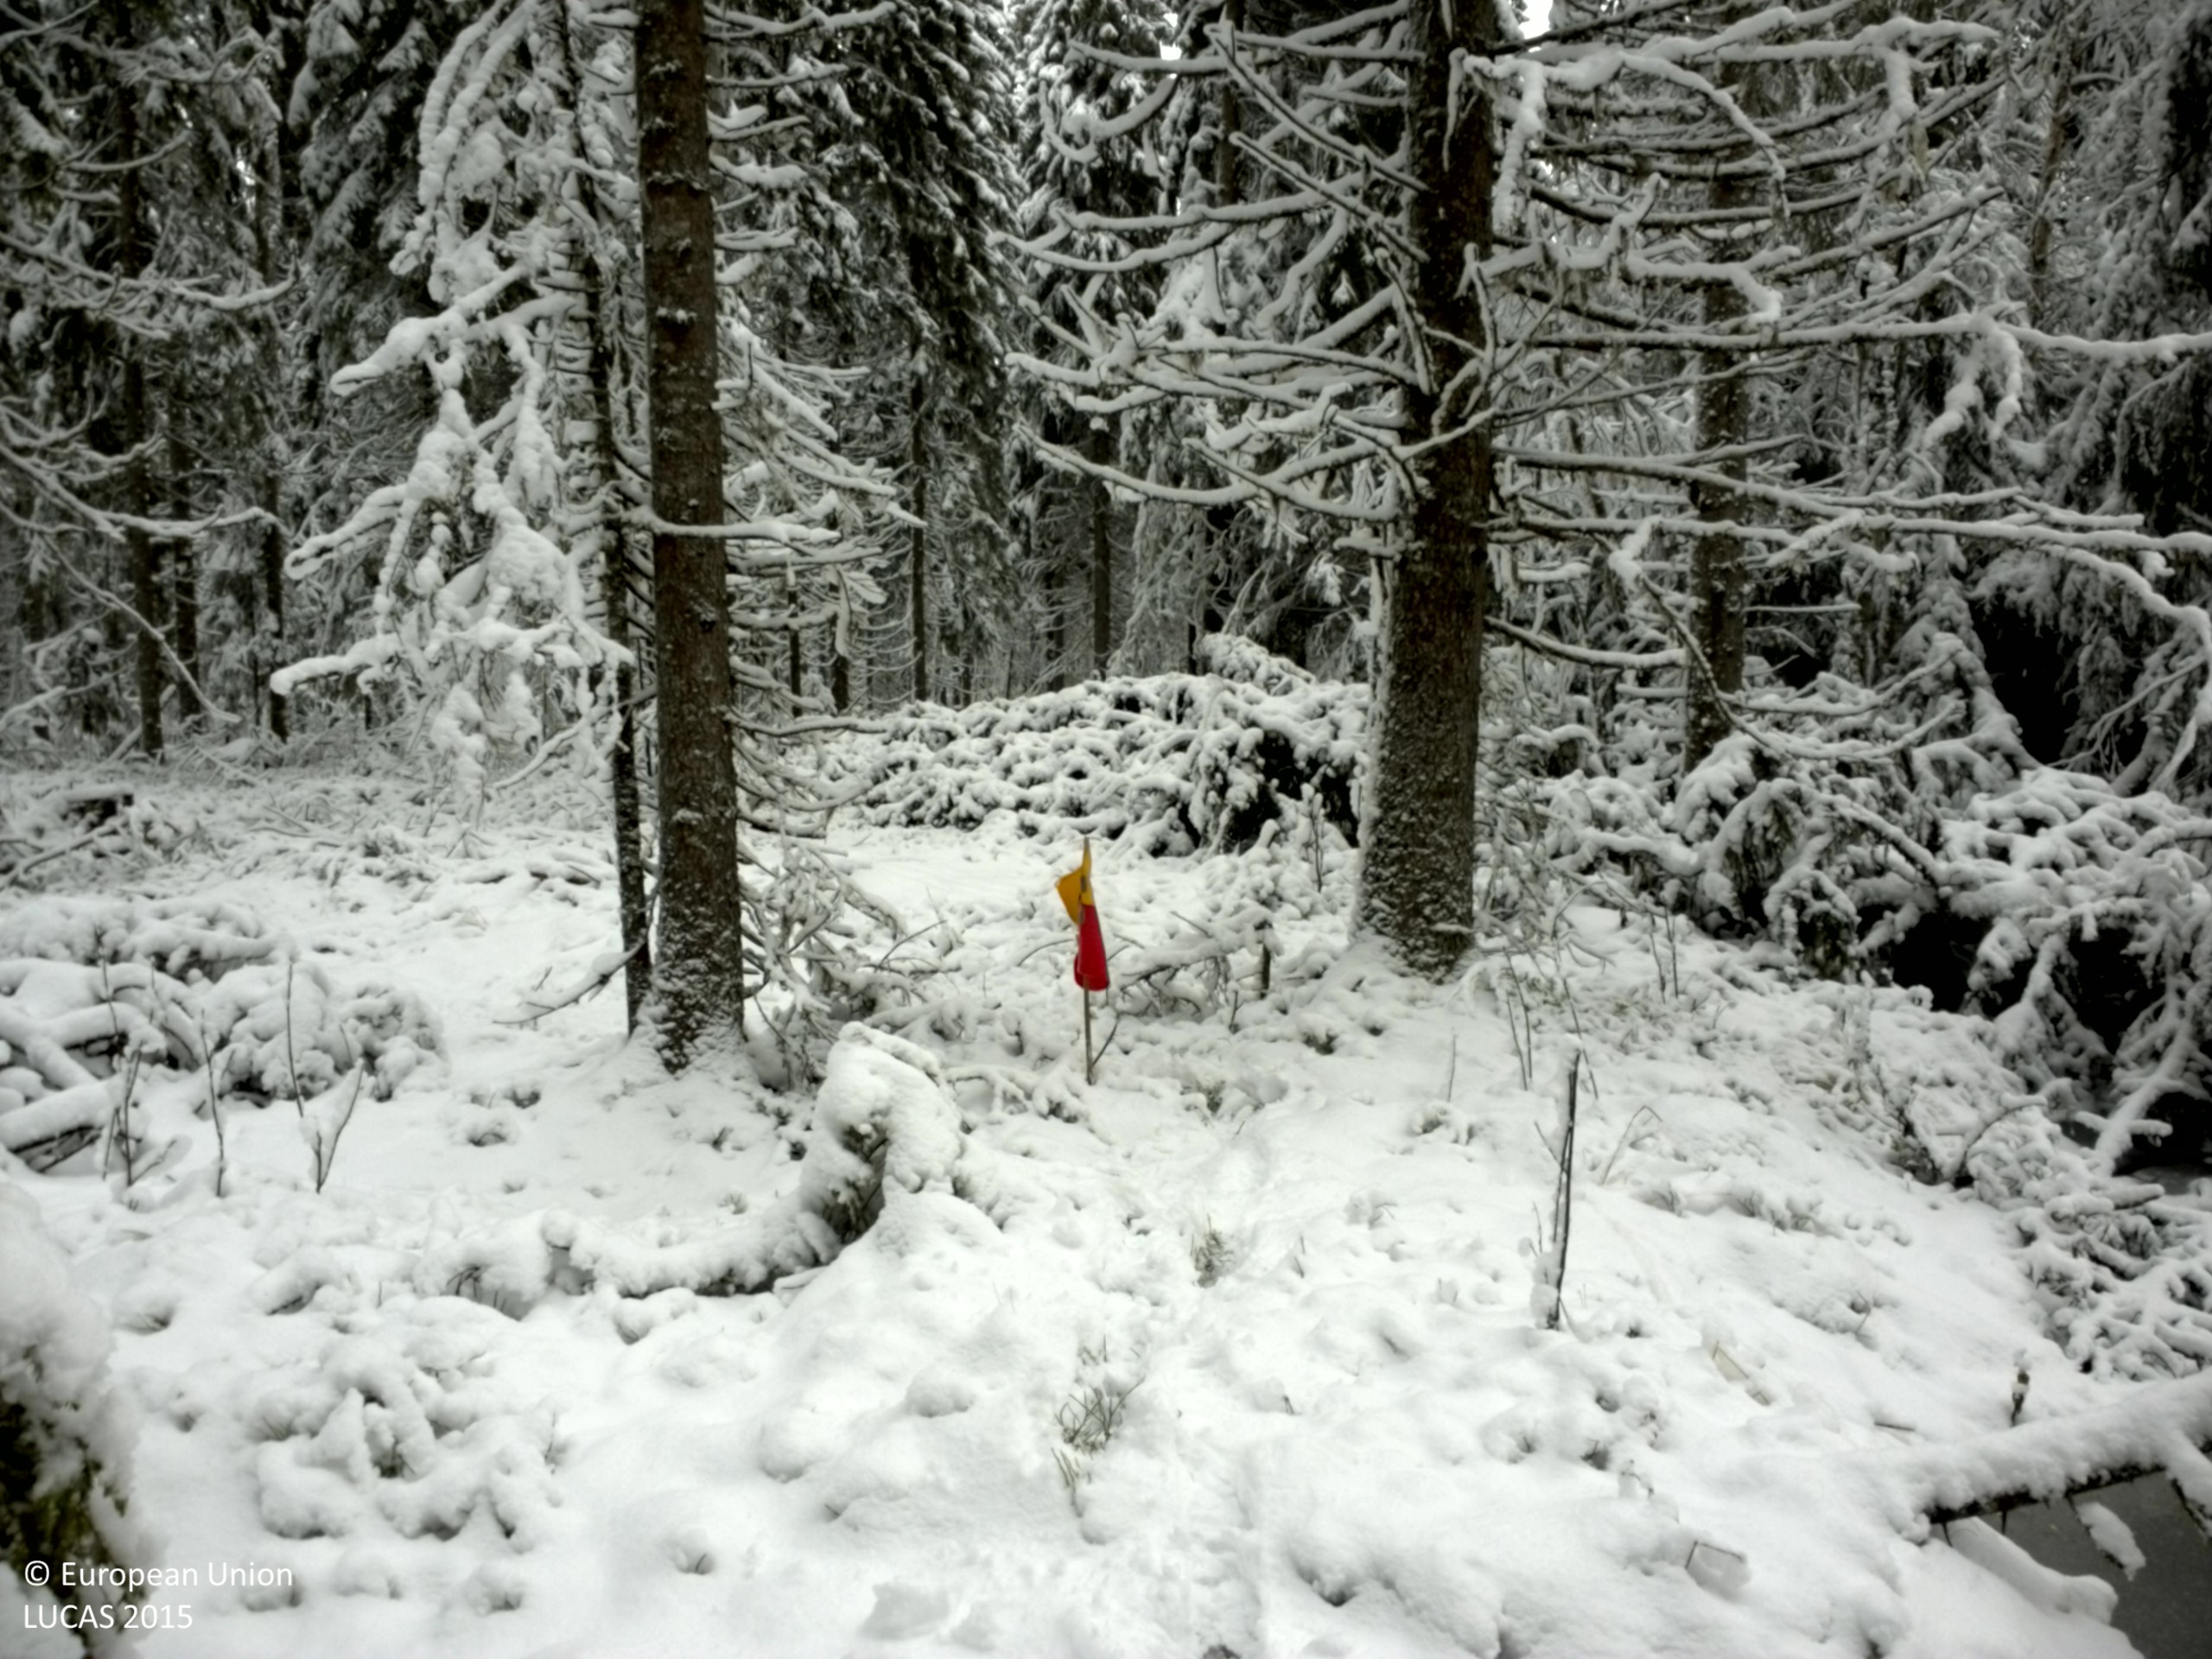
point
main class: Woodland
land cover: Spruce dominated coniferous woodland
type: boreal forest
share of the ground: > 75 %
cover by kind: coniferous forest trees 70 %, shrubs 15 %, lichens and mosses 10 %, broadleaved forest trees 5 %
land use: Forestry
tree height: > 5 m
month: November
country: SE
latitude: 63.7430
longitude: 15.4645
